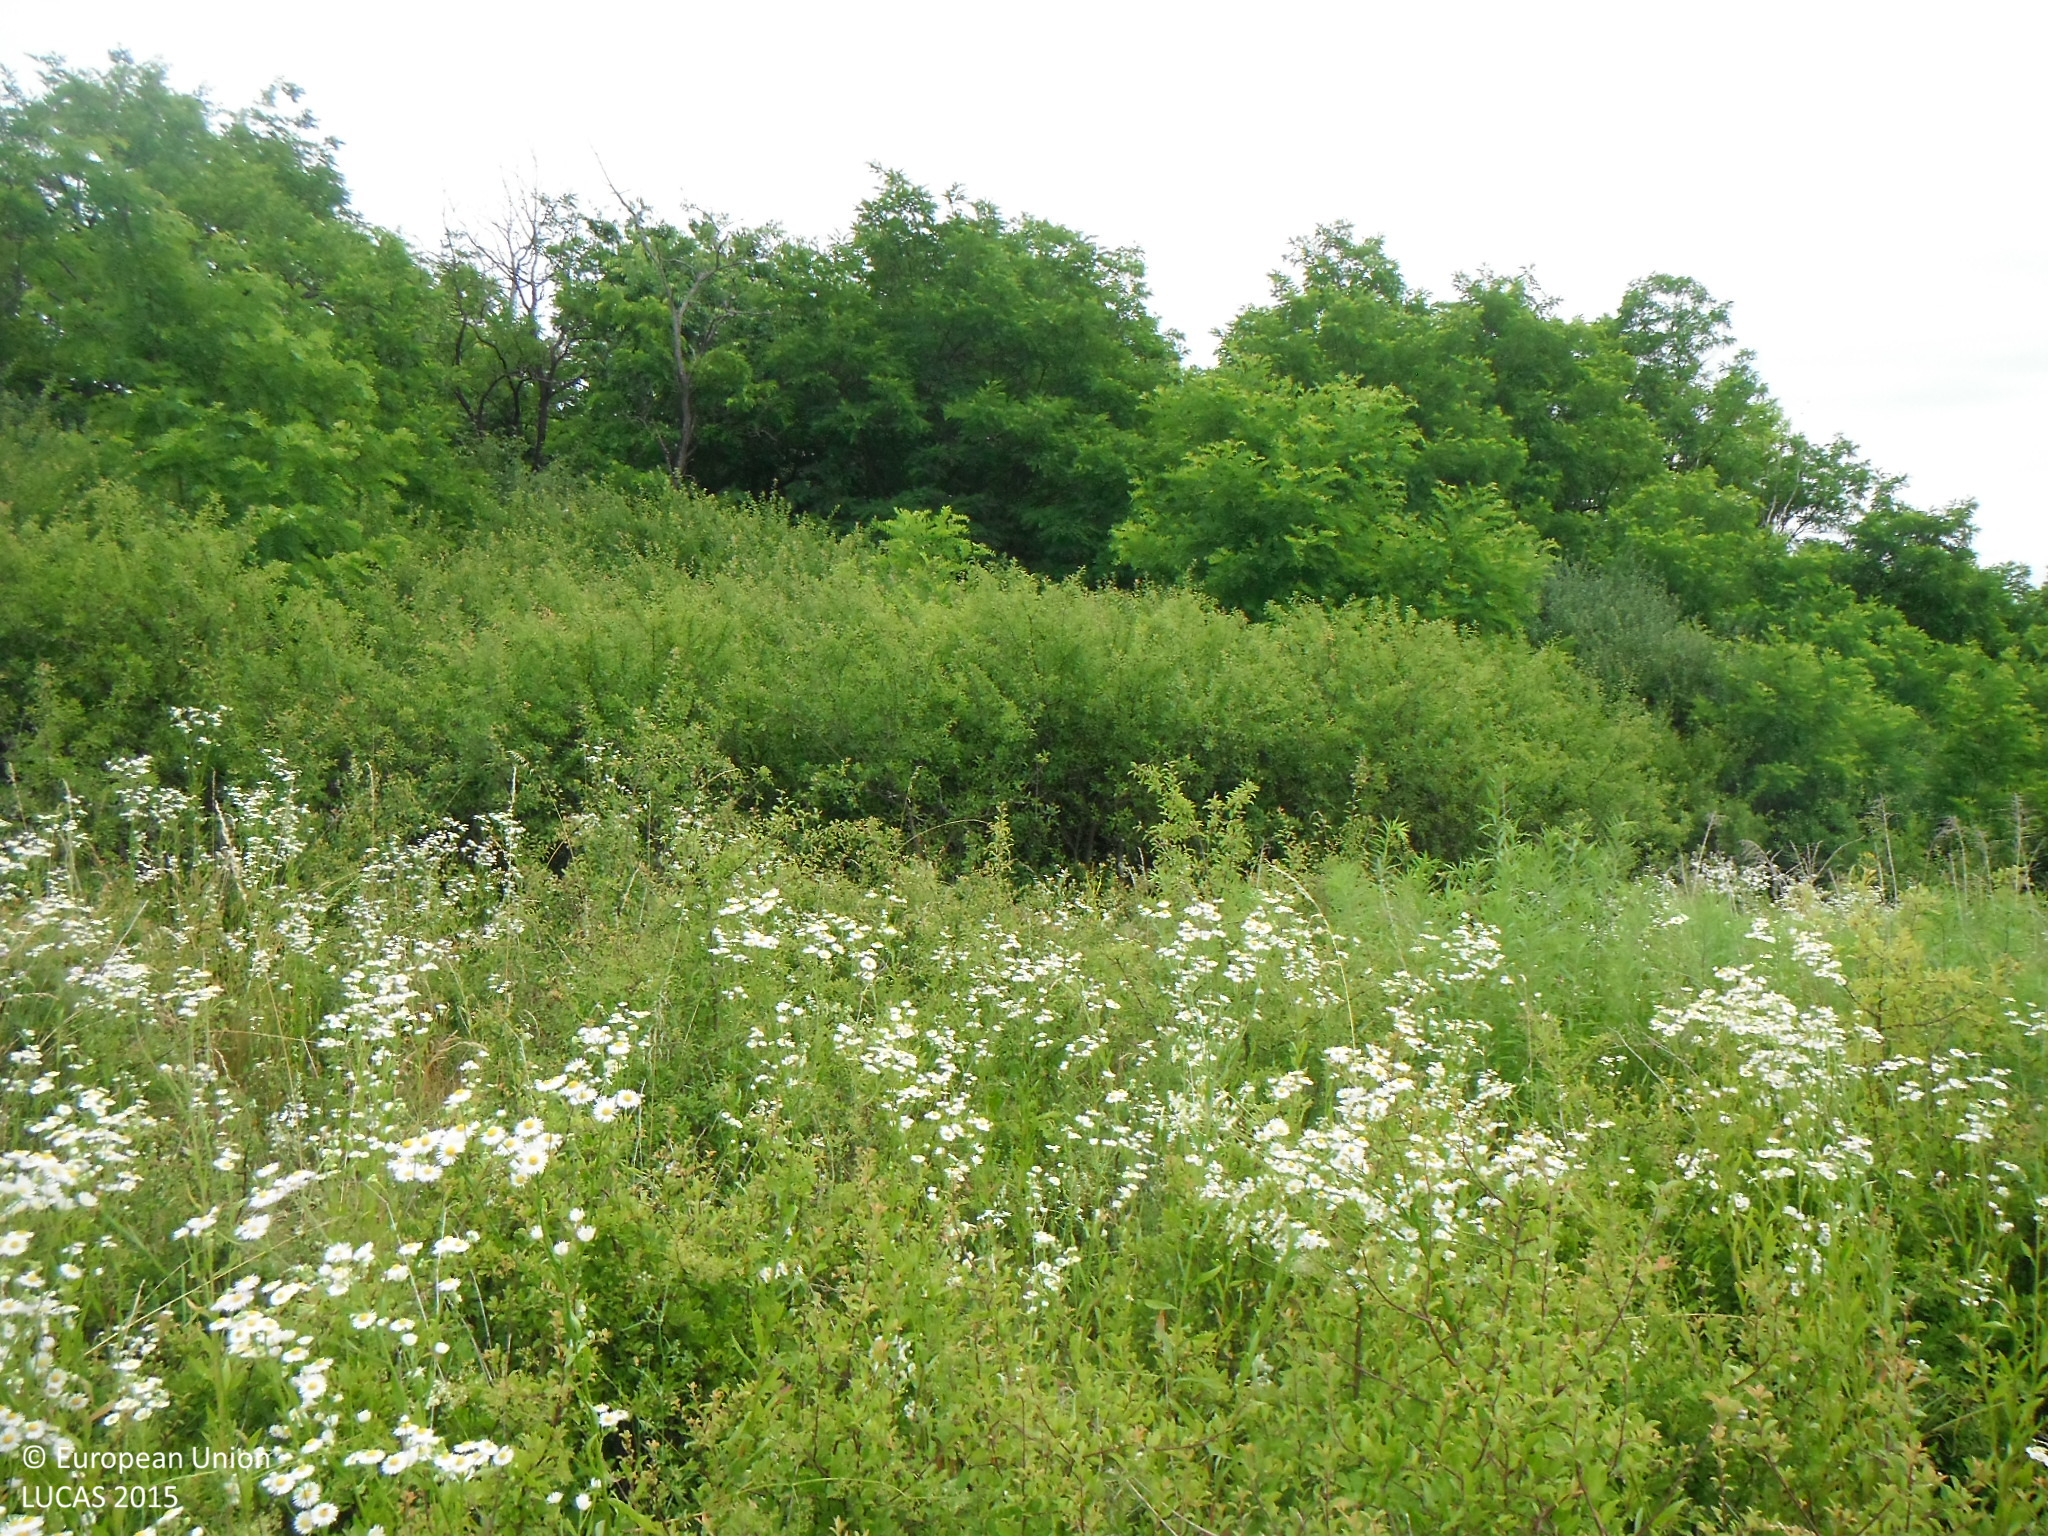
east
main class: Shrubland
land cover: Shrubland without tree cover
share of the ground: > 75 %
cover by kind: shrubs 90 %, herbaceous plants 10 %
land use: Semi-natural and natural areas not in use
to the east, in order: Shrubland without tree cover; Shrubland with sparse tree cover; Broadleaved woodland; Sunflower; Broadleaved woodland
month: June
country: SK
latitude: 48.1410
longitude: 19.4713
